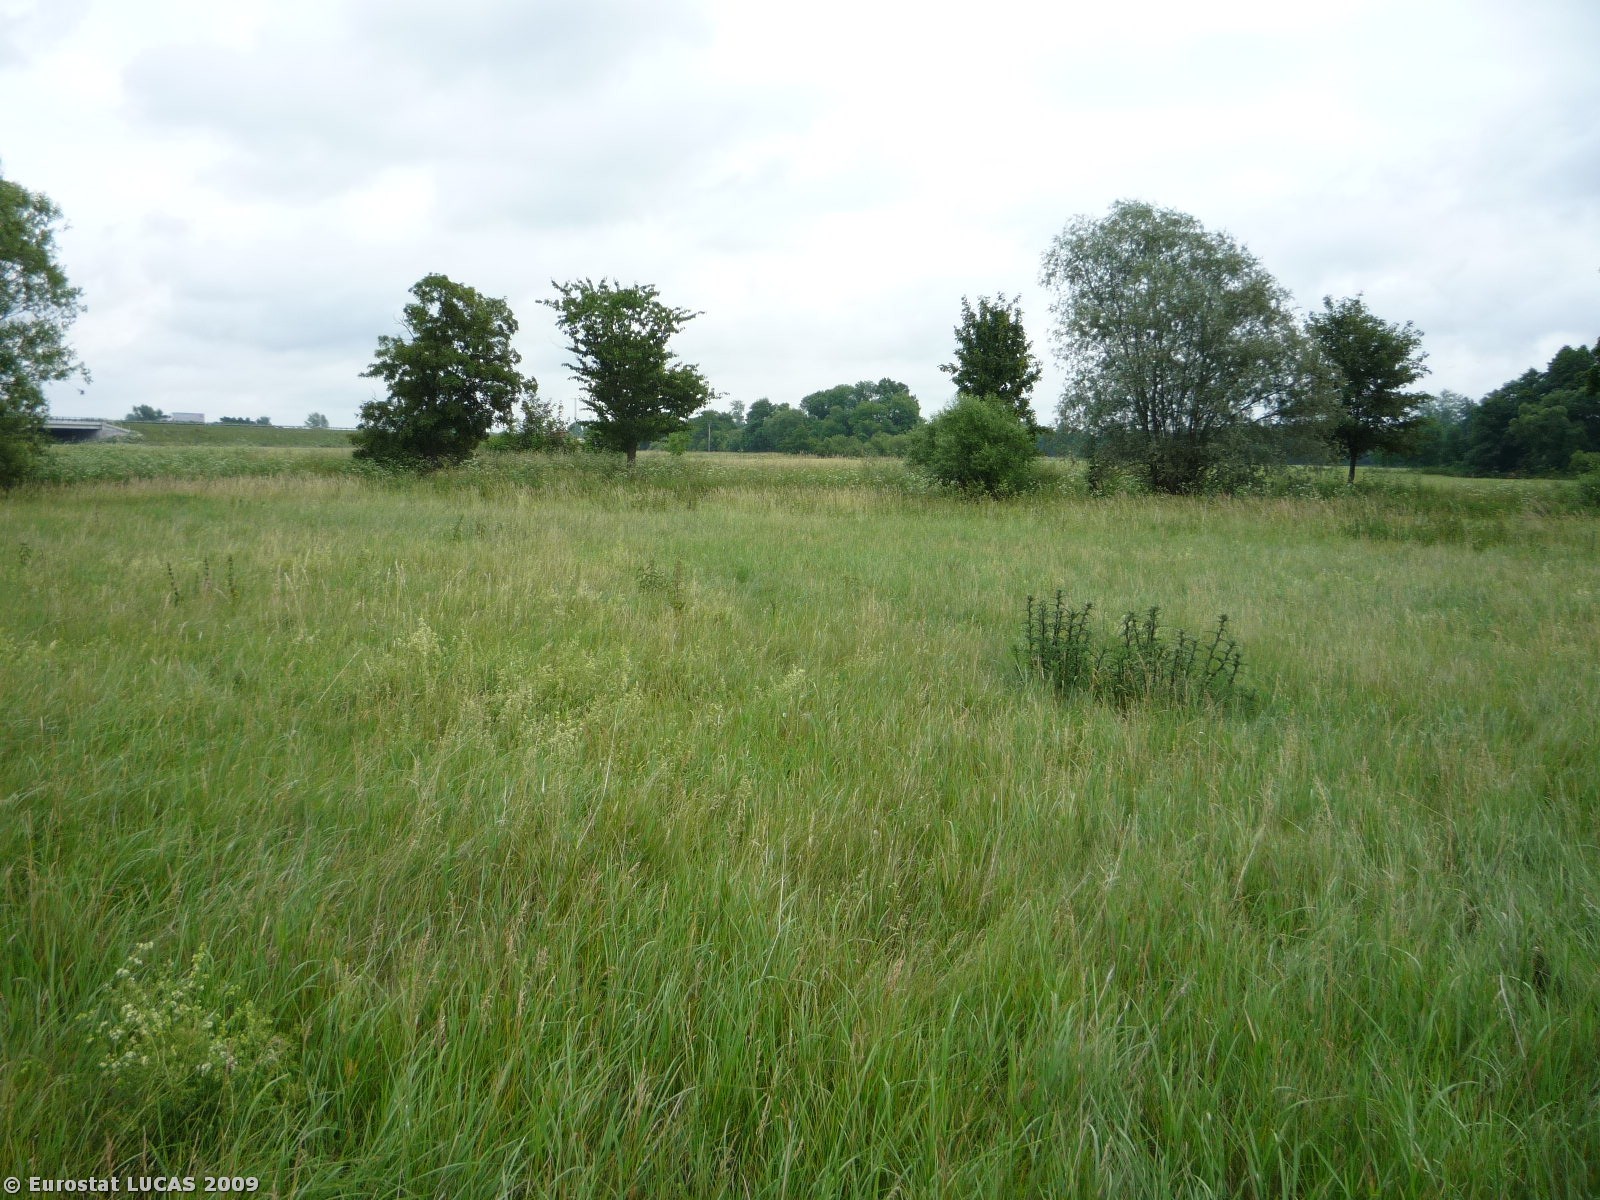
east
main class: Grassland
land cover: Grassland without tree/shrub cover
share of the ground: > 75 %
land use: Agriculture (excluding fallow land and kitchen gardens)
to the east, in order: Grassland without tree/shrub cover; Inland running water; Grassland with sparse tree/shrub cover; Tracks; Grassland without tree/shrub cover
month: June
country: CZ
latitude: 50.1263
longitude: 15.4452
